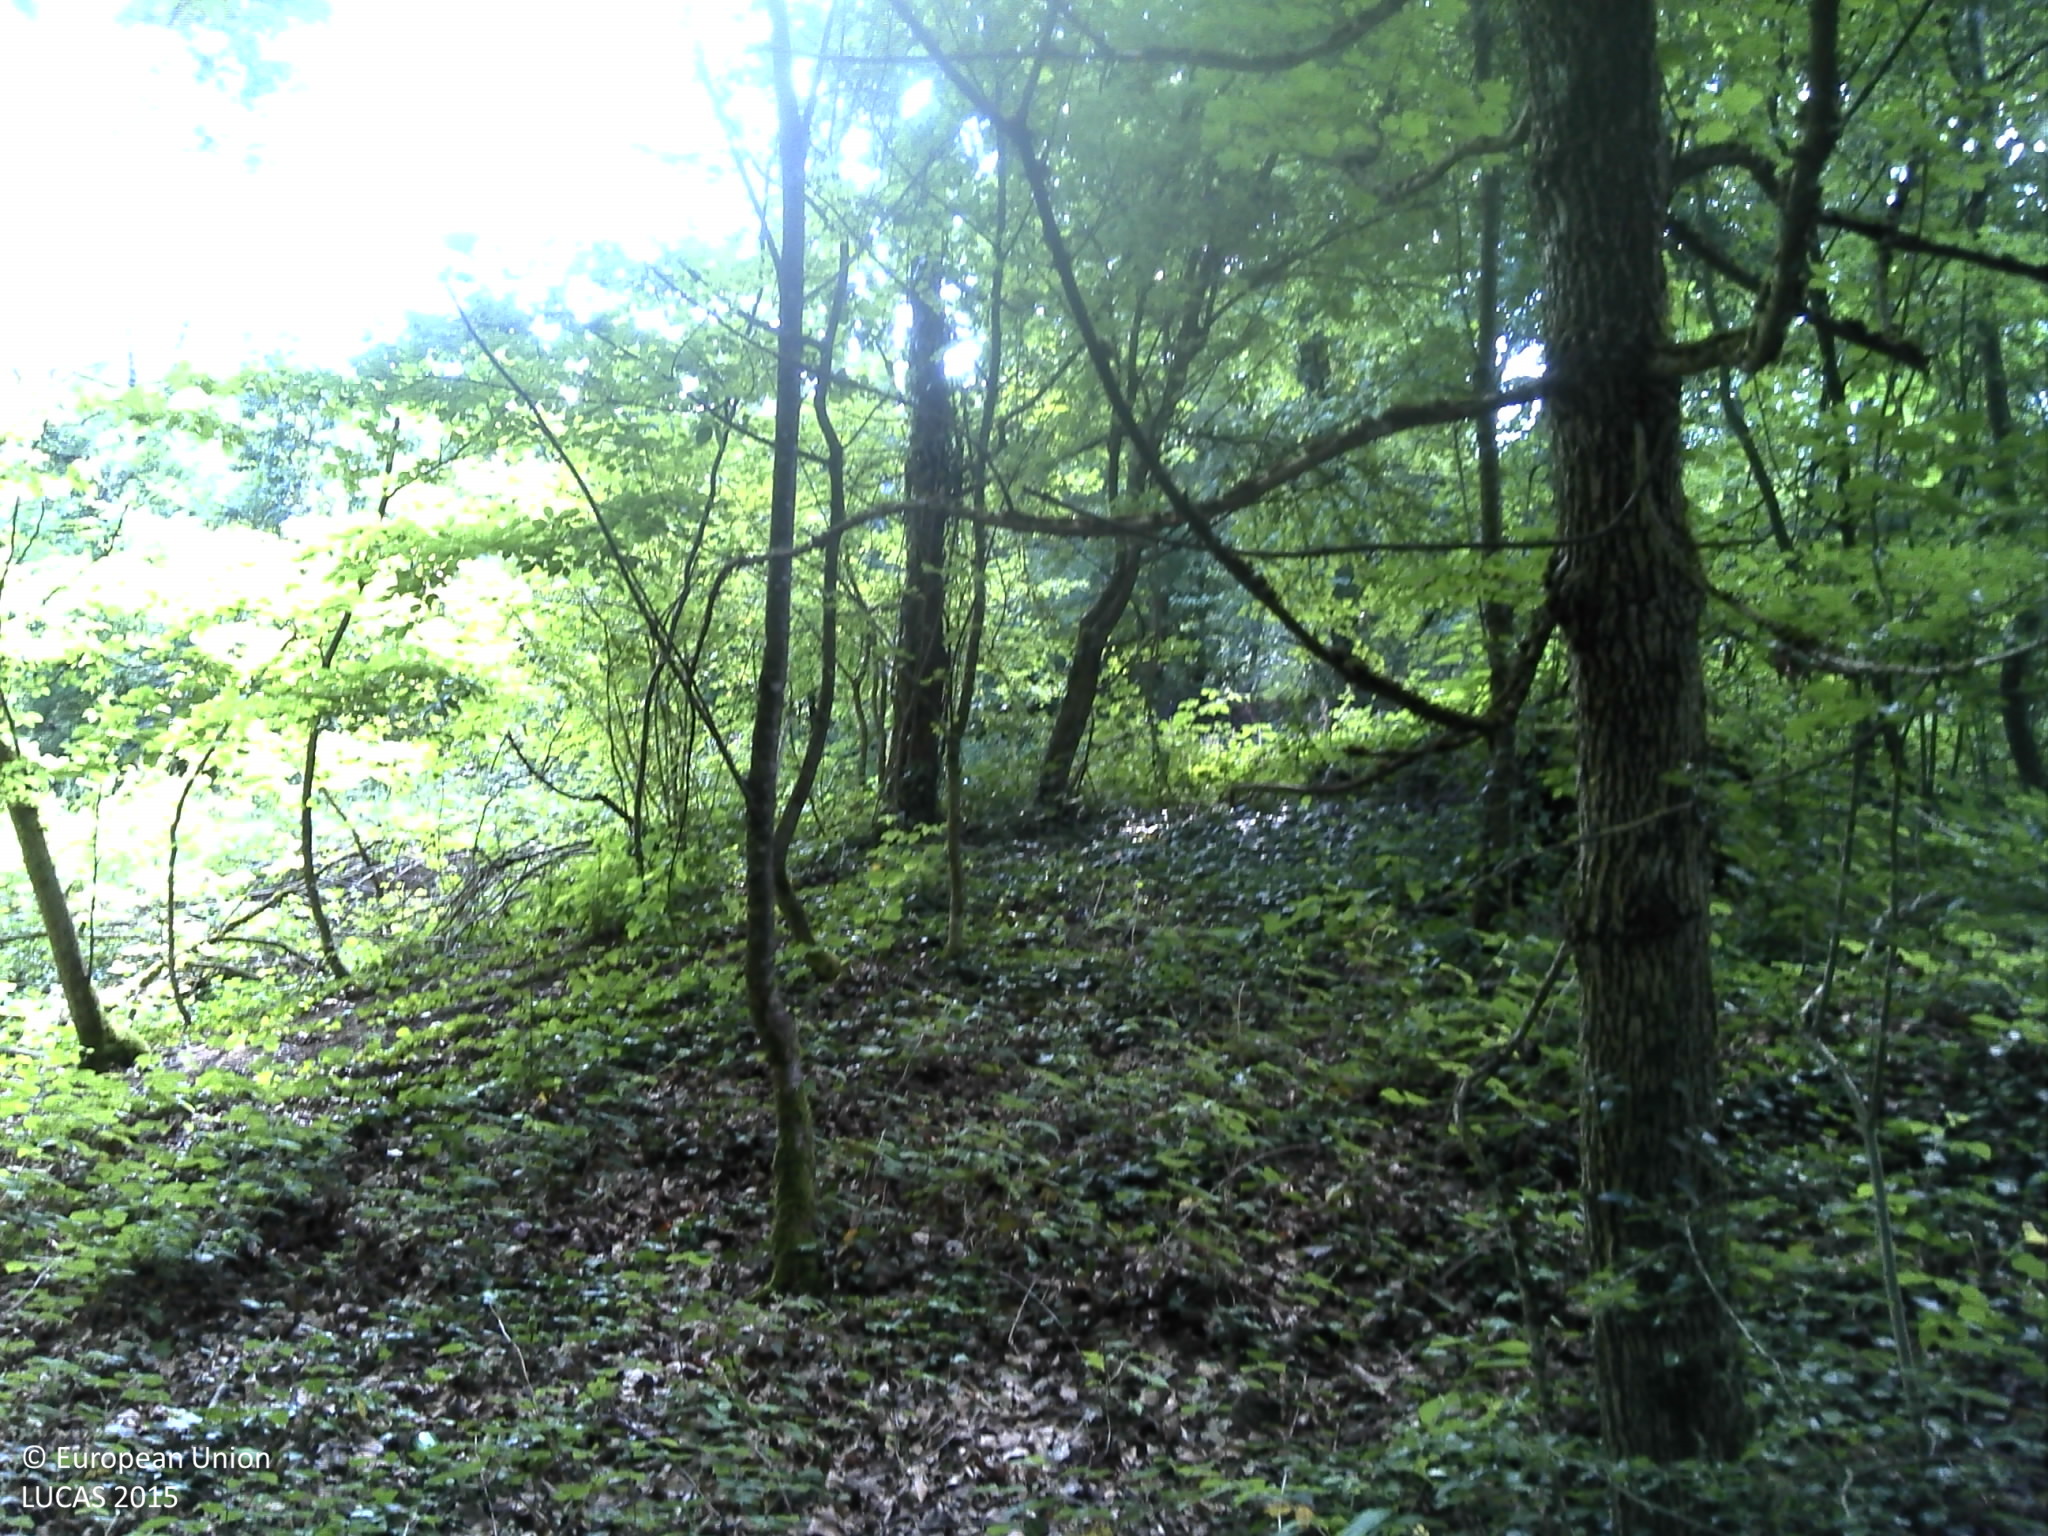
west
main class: Woodland
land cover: Broadleaved woodland
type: beech forest
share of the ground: > 75 %
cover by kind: broadleaved forest trees 100 %
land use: Forestry
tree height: > 5 m
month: June
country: FR
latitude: 49.0230
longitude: 6.7866
